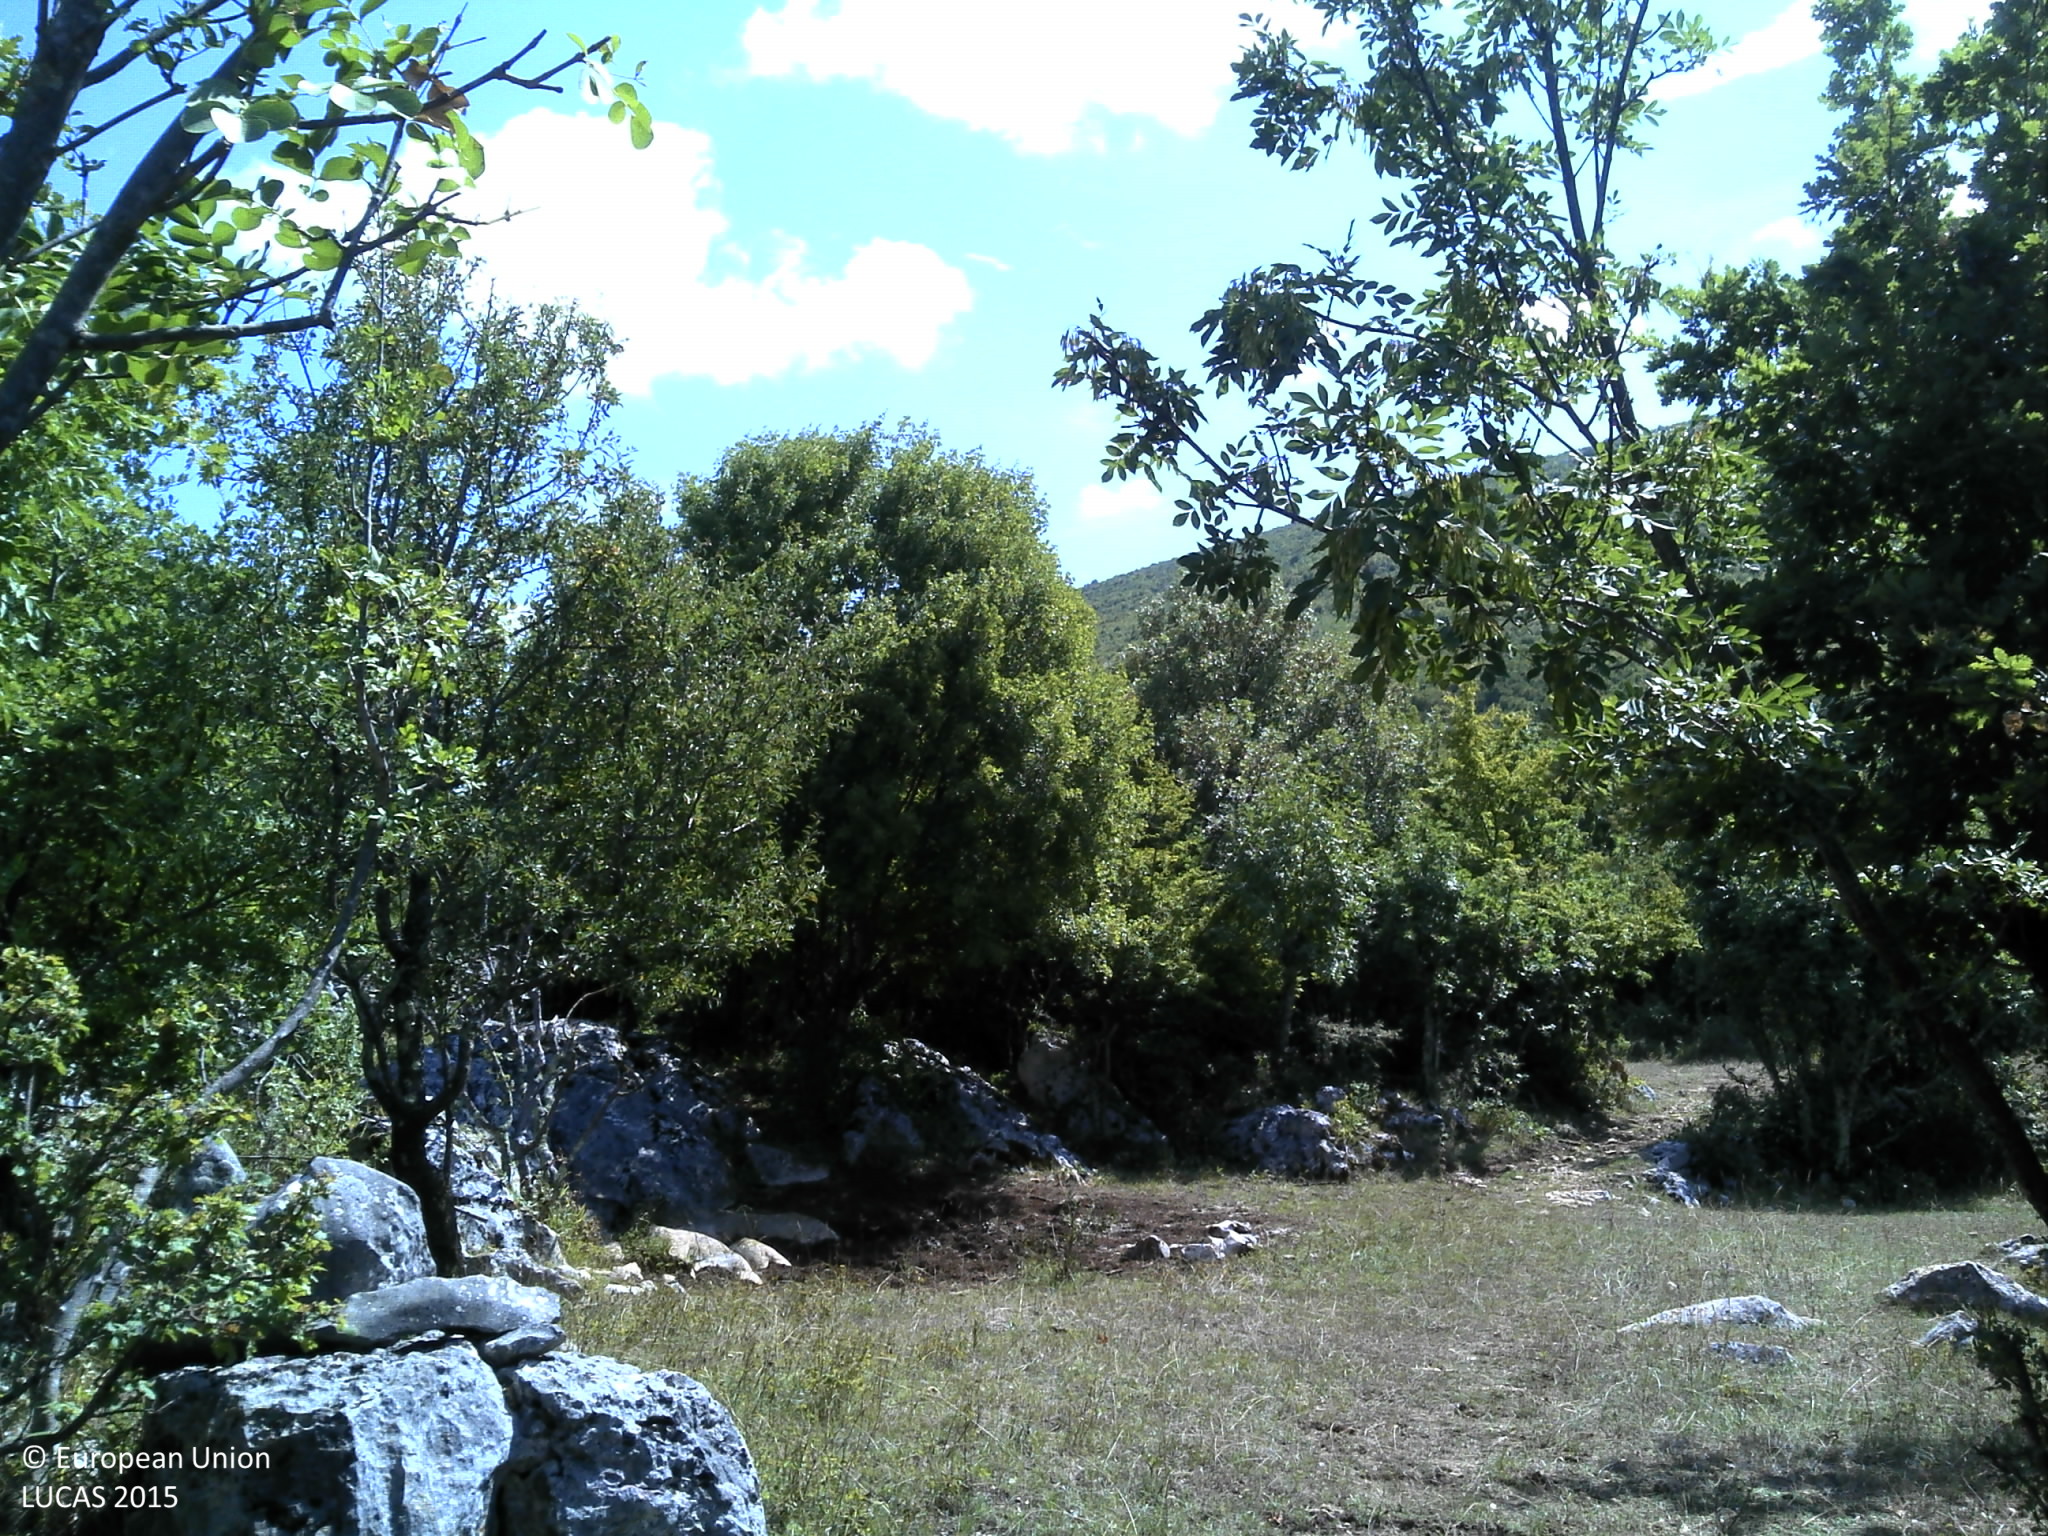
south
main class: Woodland
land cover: Broadleaved woodland
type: thermophilous deciduous forest
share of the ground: 25 - 50 %
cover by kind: broadleaved forest trees 40 %, herbaceous plants 30 %, shrubs 15 %, consolidated bare surface 10 %, unconsolidated bare surface 5 %
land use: Abandoned areas
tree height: > 5 m
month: August
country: HR
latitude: 44.1131
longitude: 15.8523
